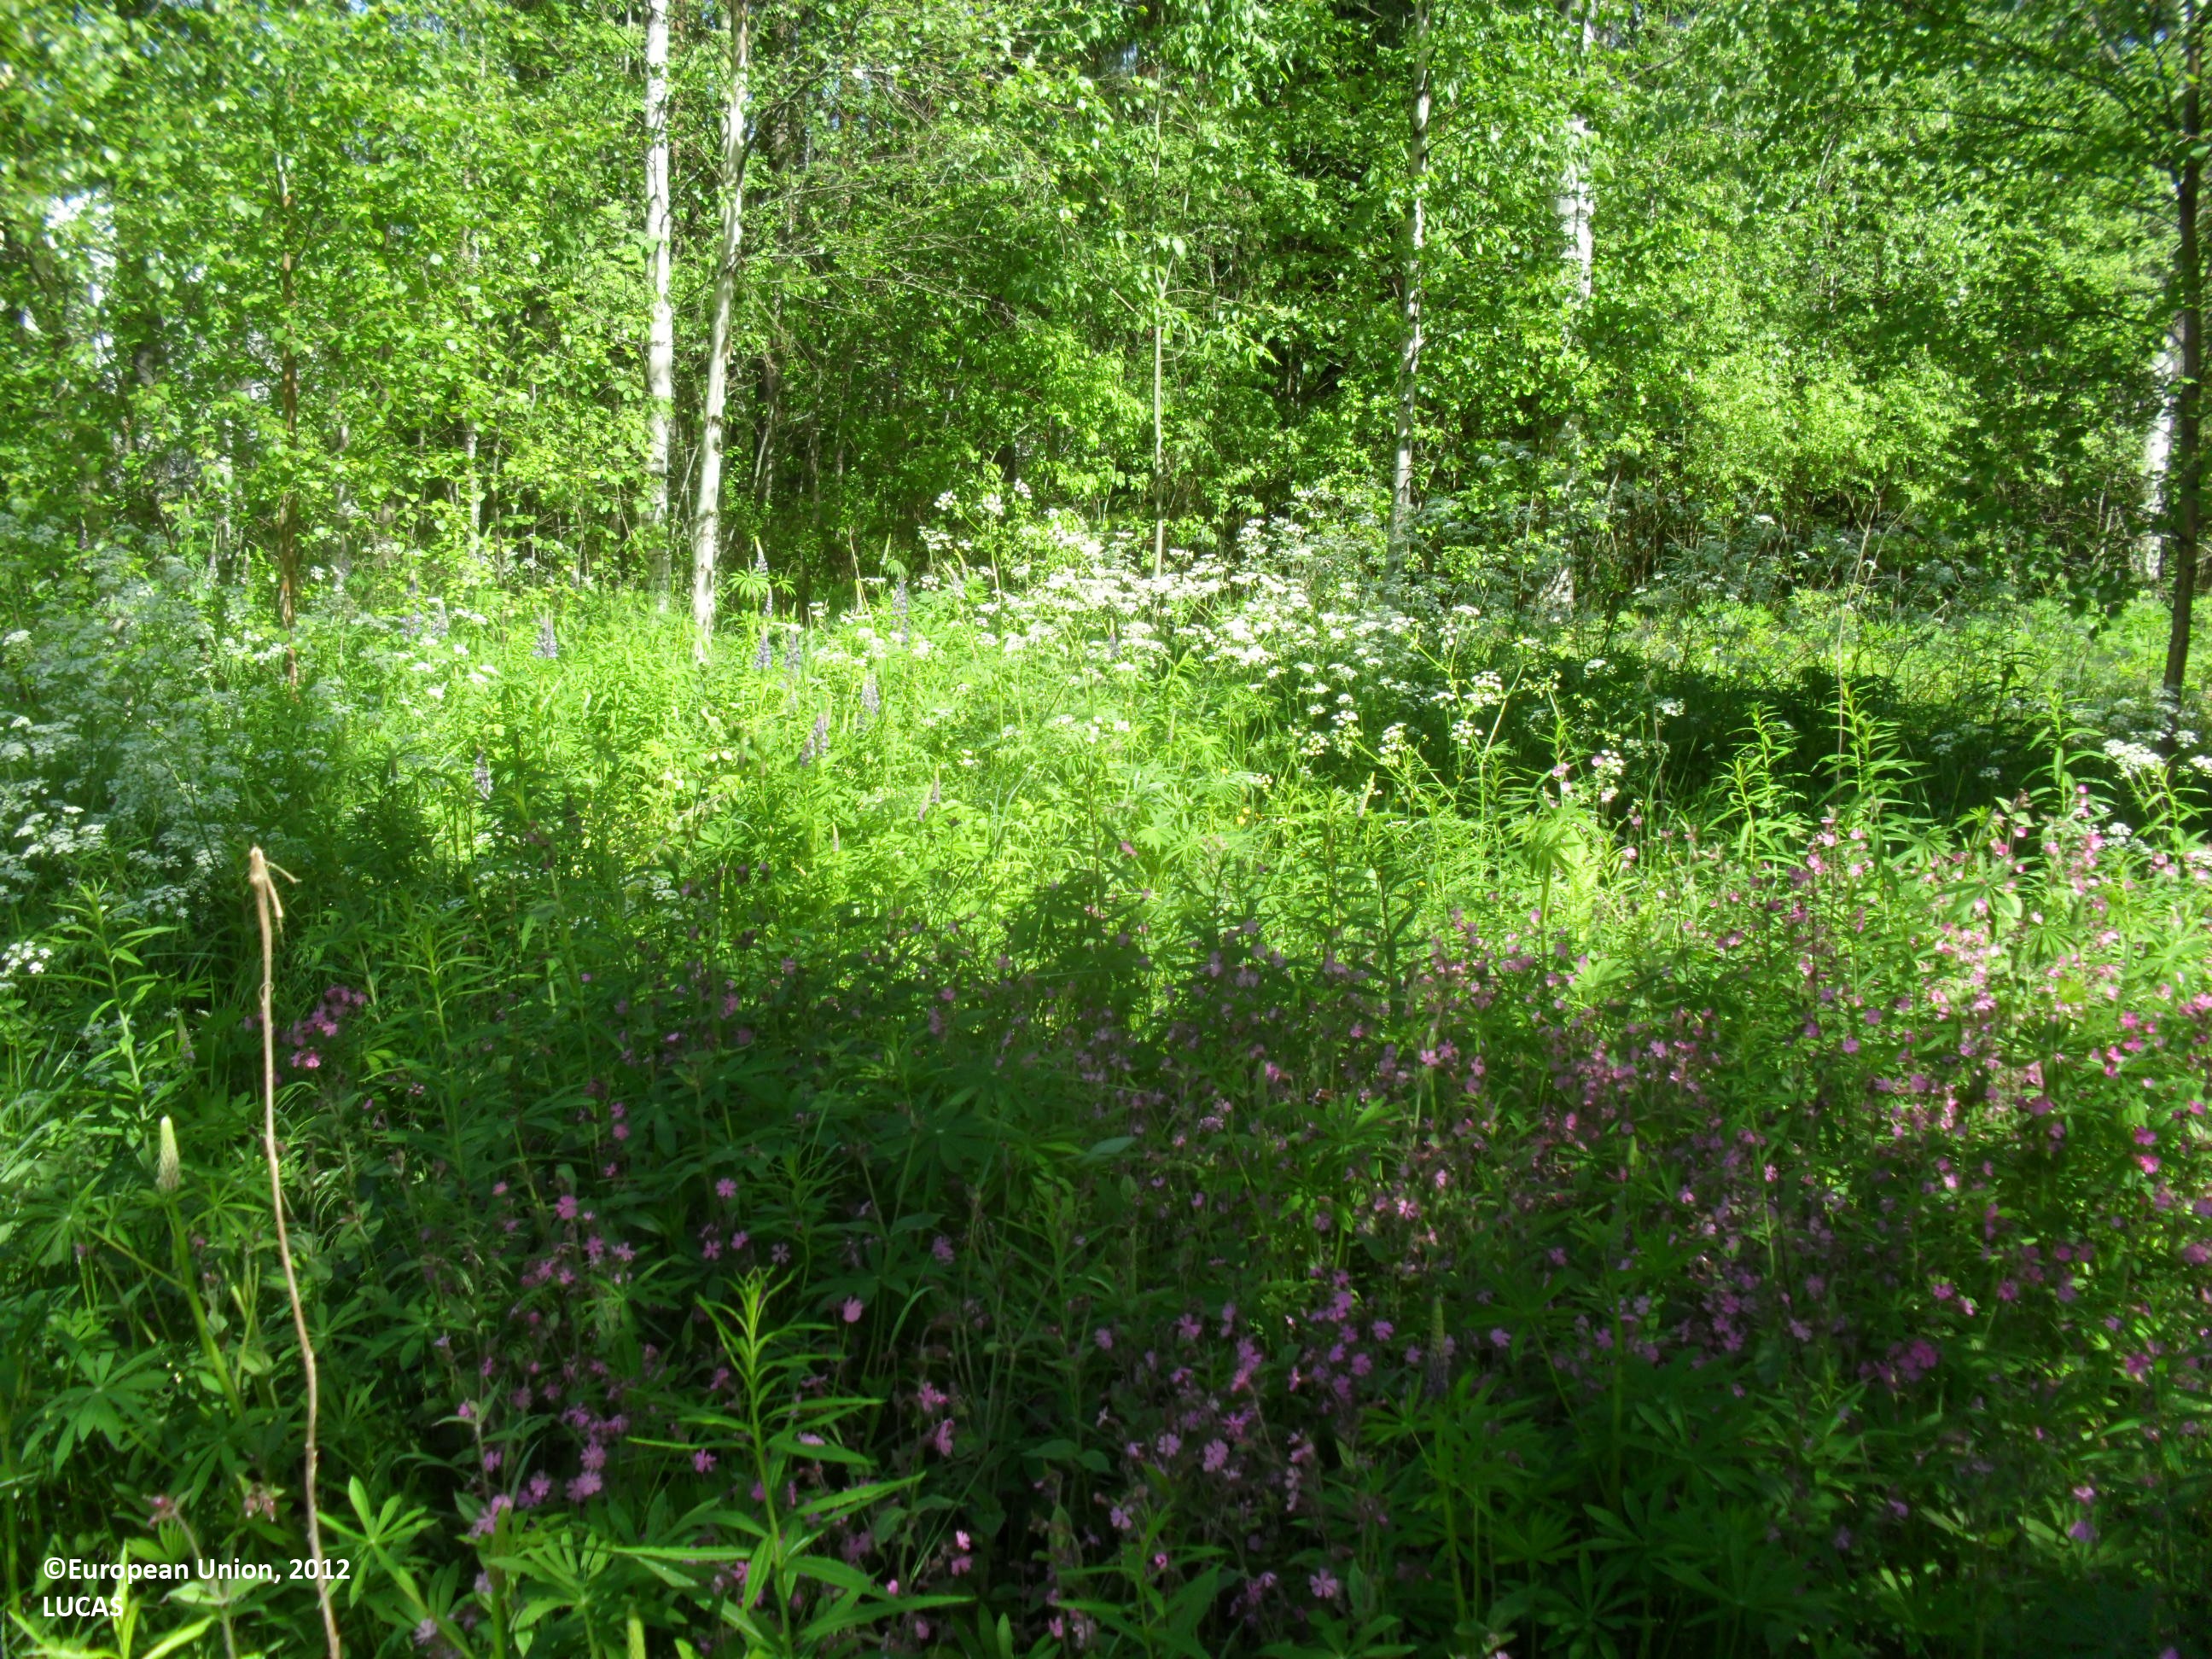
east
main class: Grassland
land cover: Grassland with sparse tree/shrub cover
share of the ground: 25 - 50 %
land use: Residential
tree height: > 5 m
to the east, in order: Grassland with sparse tree/shrub cover; Spontaneously vegetated surfaces; Other mixed woodland; Pine dominated mixed woodland; Ditches and canals; Pine dominated mixed woodland; Artificial constructions in urban areas; Spruce dominated coniferous woodland; Other mixed woodland
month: June
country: FI
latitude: 63.2965
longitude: 23.1631
